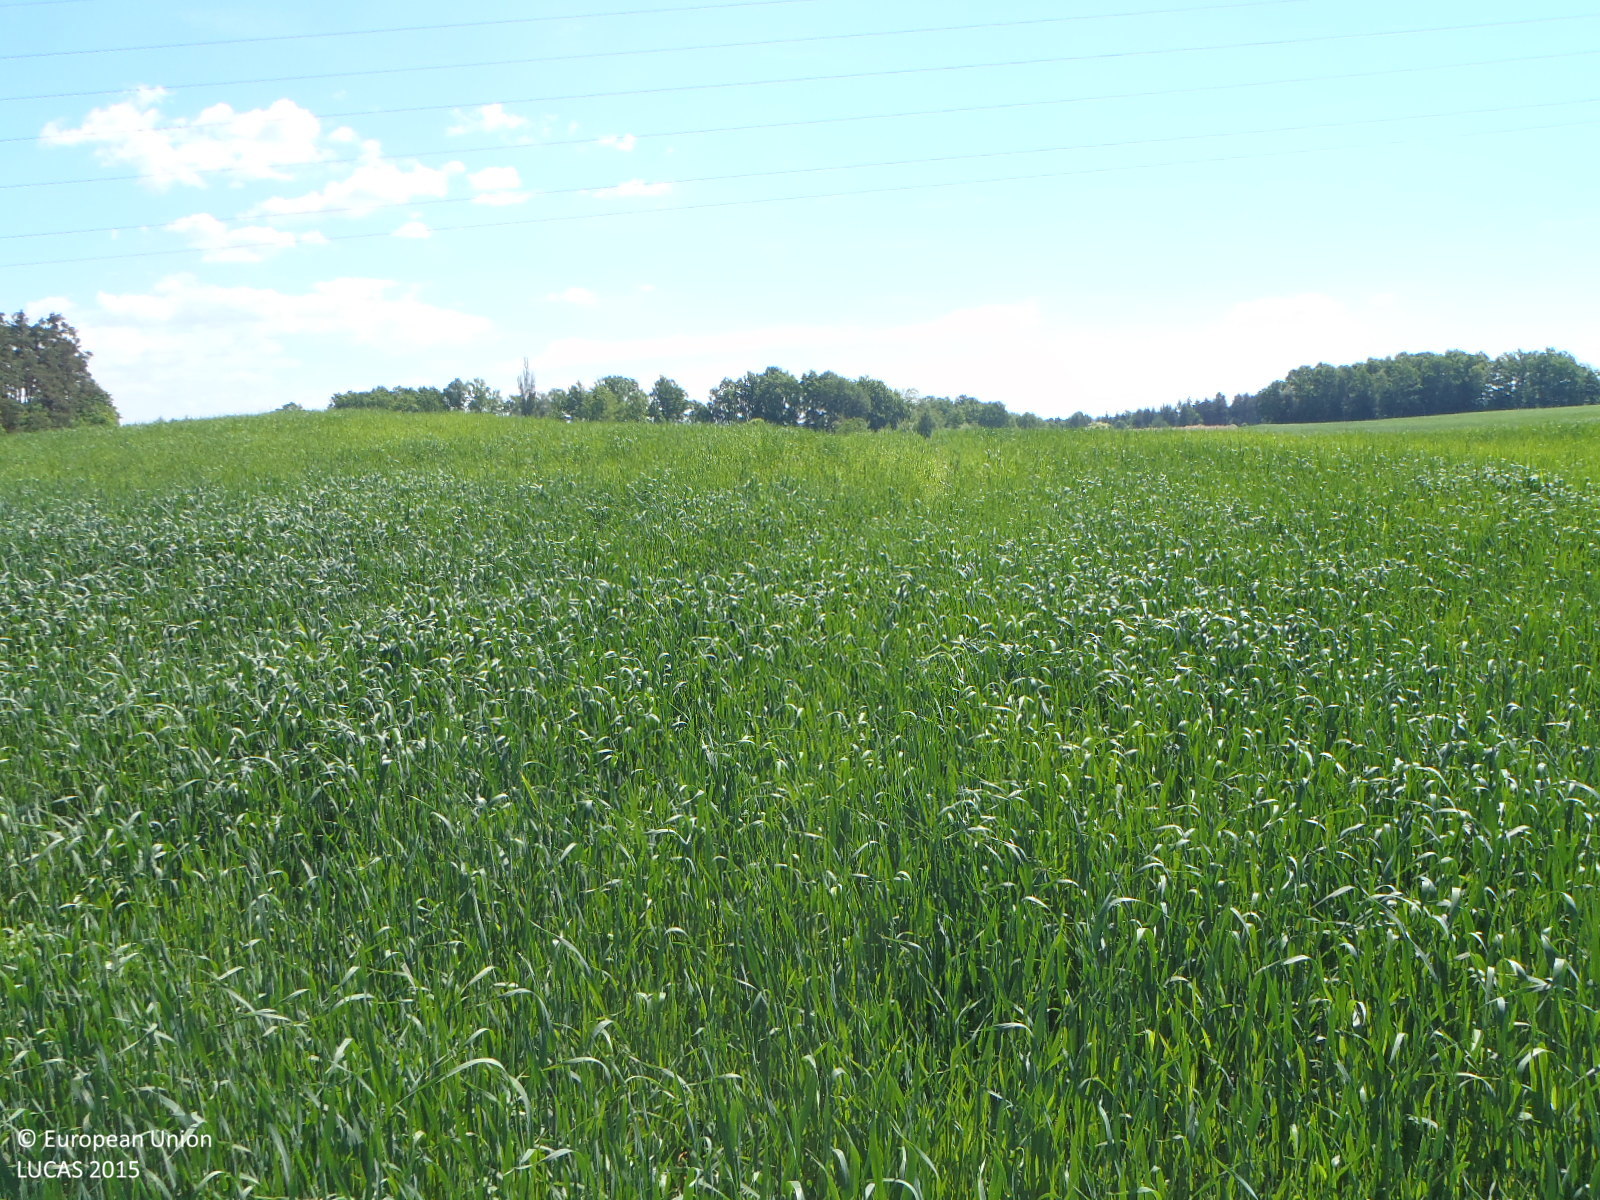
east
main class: Cropland
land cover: Oats
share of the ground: > 75 %
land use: Agriculture (excluding fallow land and kitchen gardens)
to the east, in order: Oats; Electric lines; Oats; Grassland without tree/shrub cover
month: June
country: CZ
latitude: 48.8933
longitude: 14.3792
